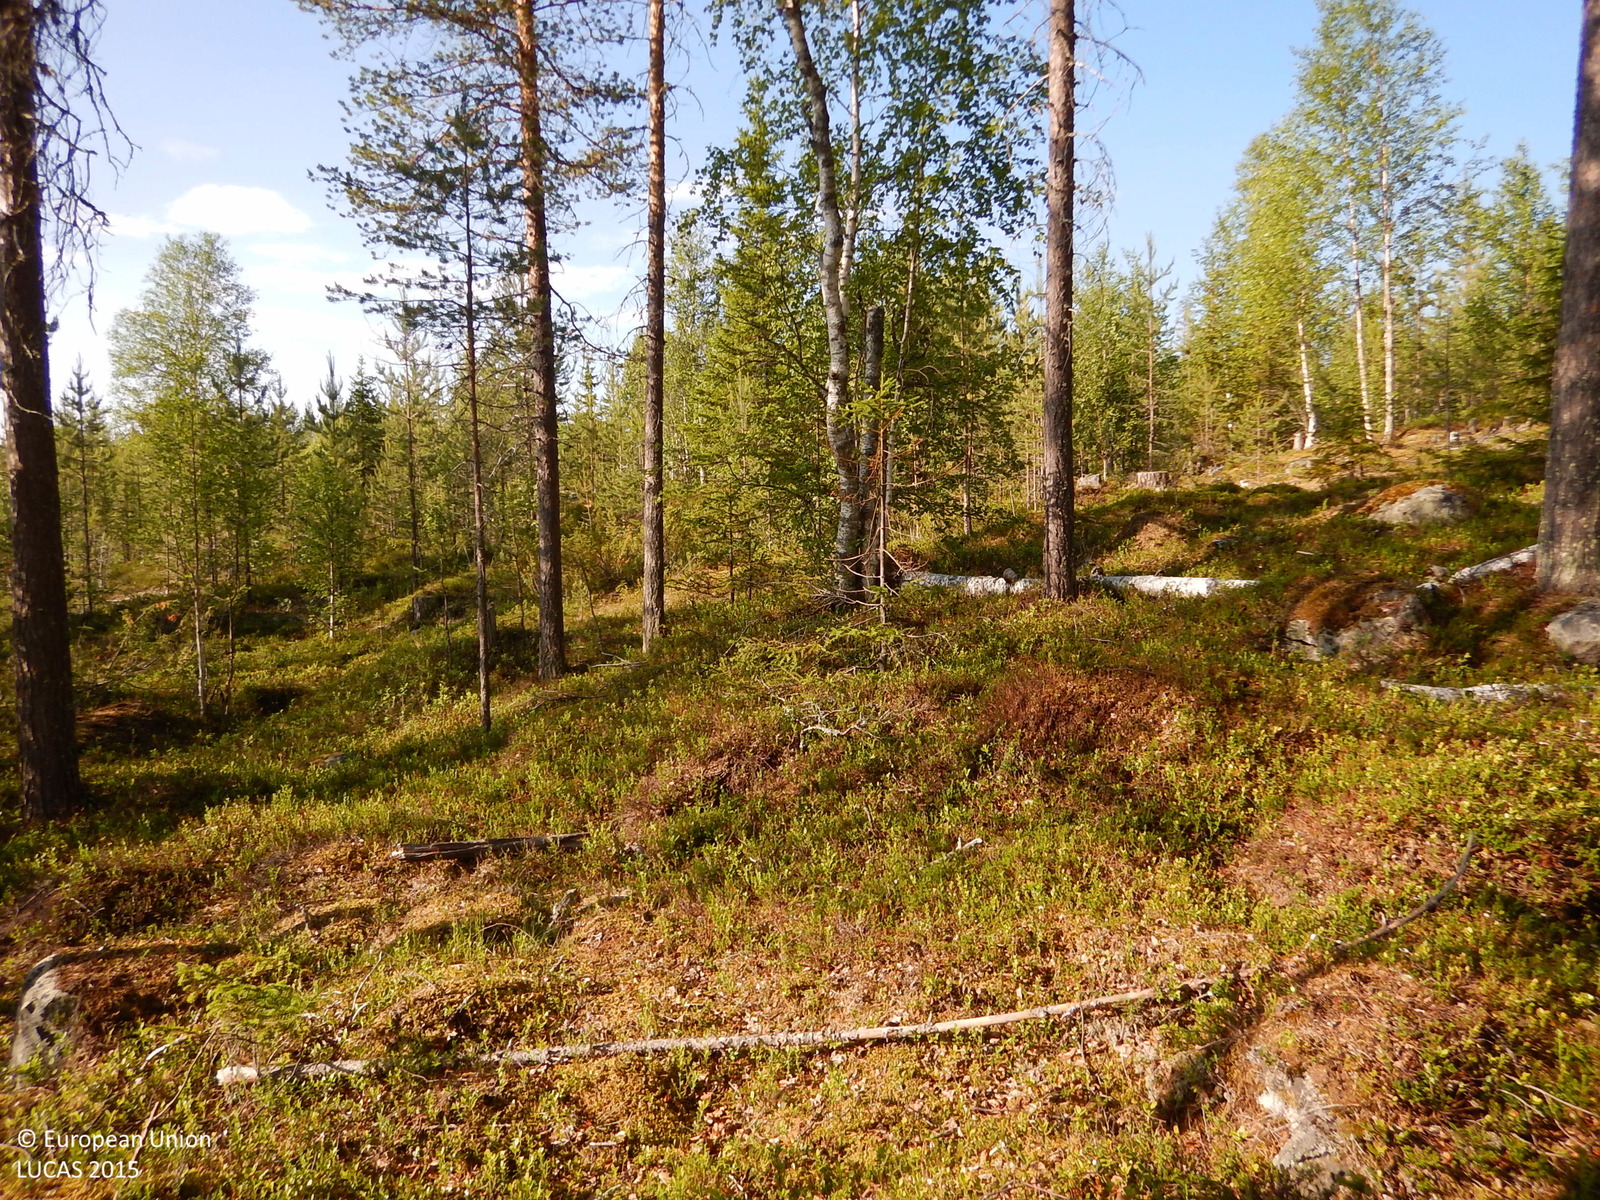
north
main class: Woodland
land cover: Pine dominated coniferous woodland
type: boreal forest
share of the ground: 50 - 75 %
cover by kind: coniferous forest trees 50 %, lichens and mosses 15 %, shrubs 10 %, herbaceous plants 10 %, broadleaved forest trees 5 %, consolidated bare surface 5 %, unconsolidated bare surface 5 %
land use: Forestry
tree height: > 5 m
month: September
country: SE
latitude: 64.9656
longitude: 20.1578
